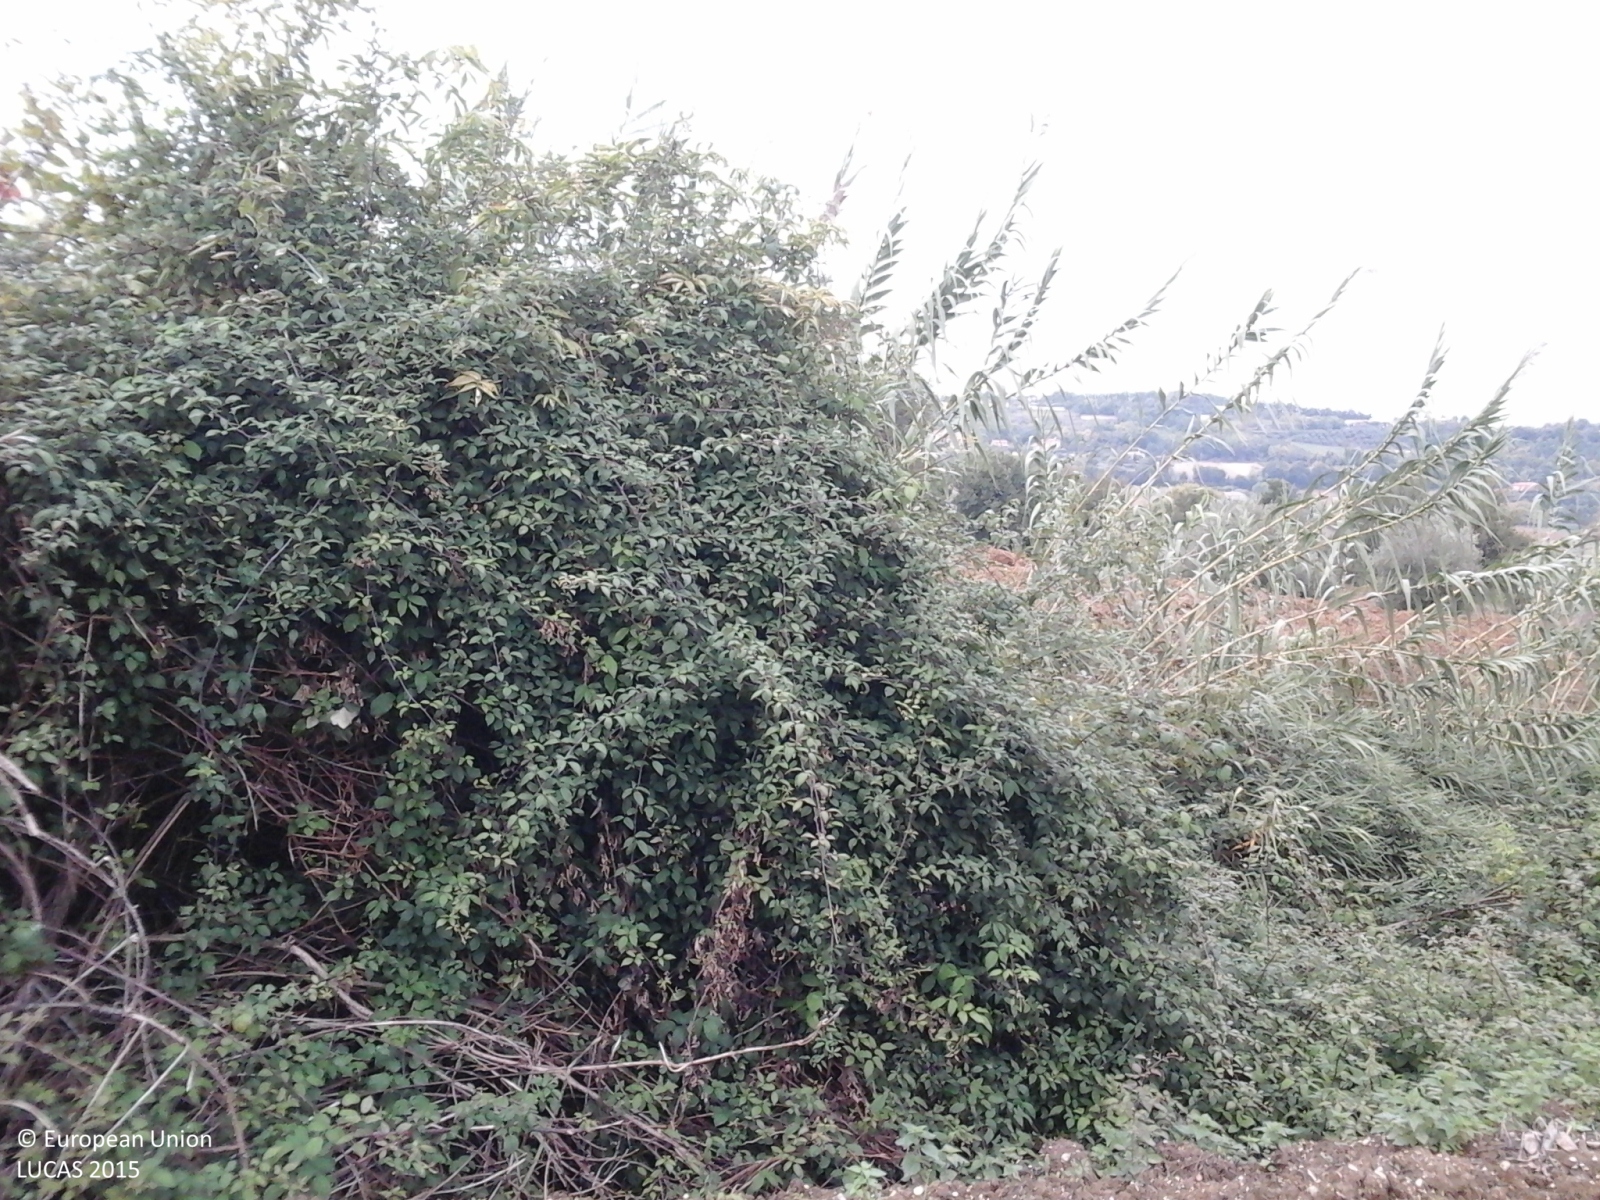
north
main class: Cropland
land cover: Durum wheat
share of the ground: < 10 %
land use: Agriculture (excluding fallow land and kitchen gardens)
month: October
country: IT
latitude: 43.5170
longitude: 13.4431
